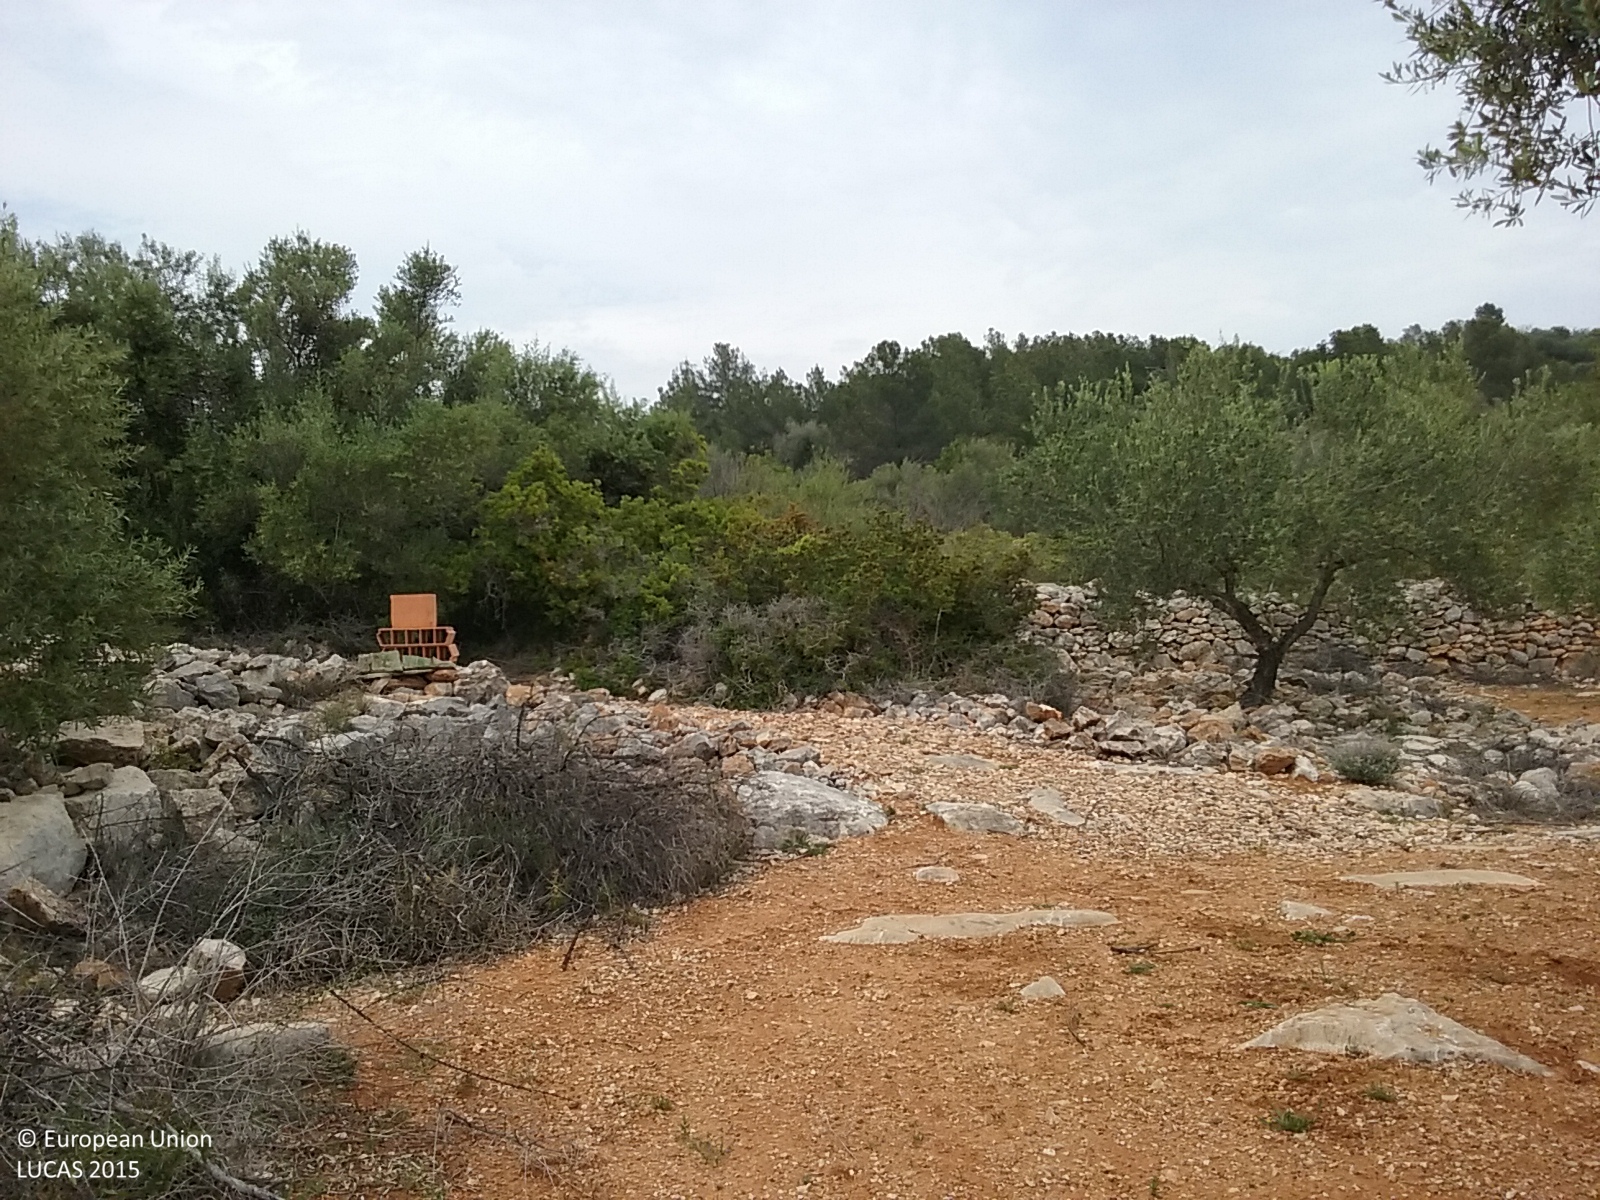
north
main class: Cropland
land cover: Olive groves
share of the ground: 50 - 75 %
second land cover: Other bare soil
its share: > 75 %
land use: Agriculture (excluding fallow land and kitchen gardens)
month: May
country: ES
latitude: 40.4809
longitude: 0.3347
